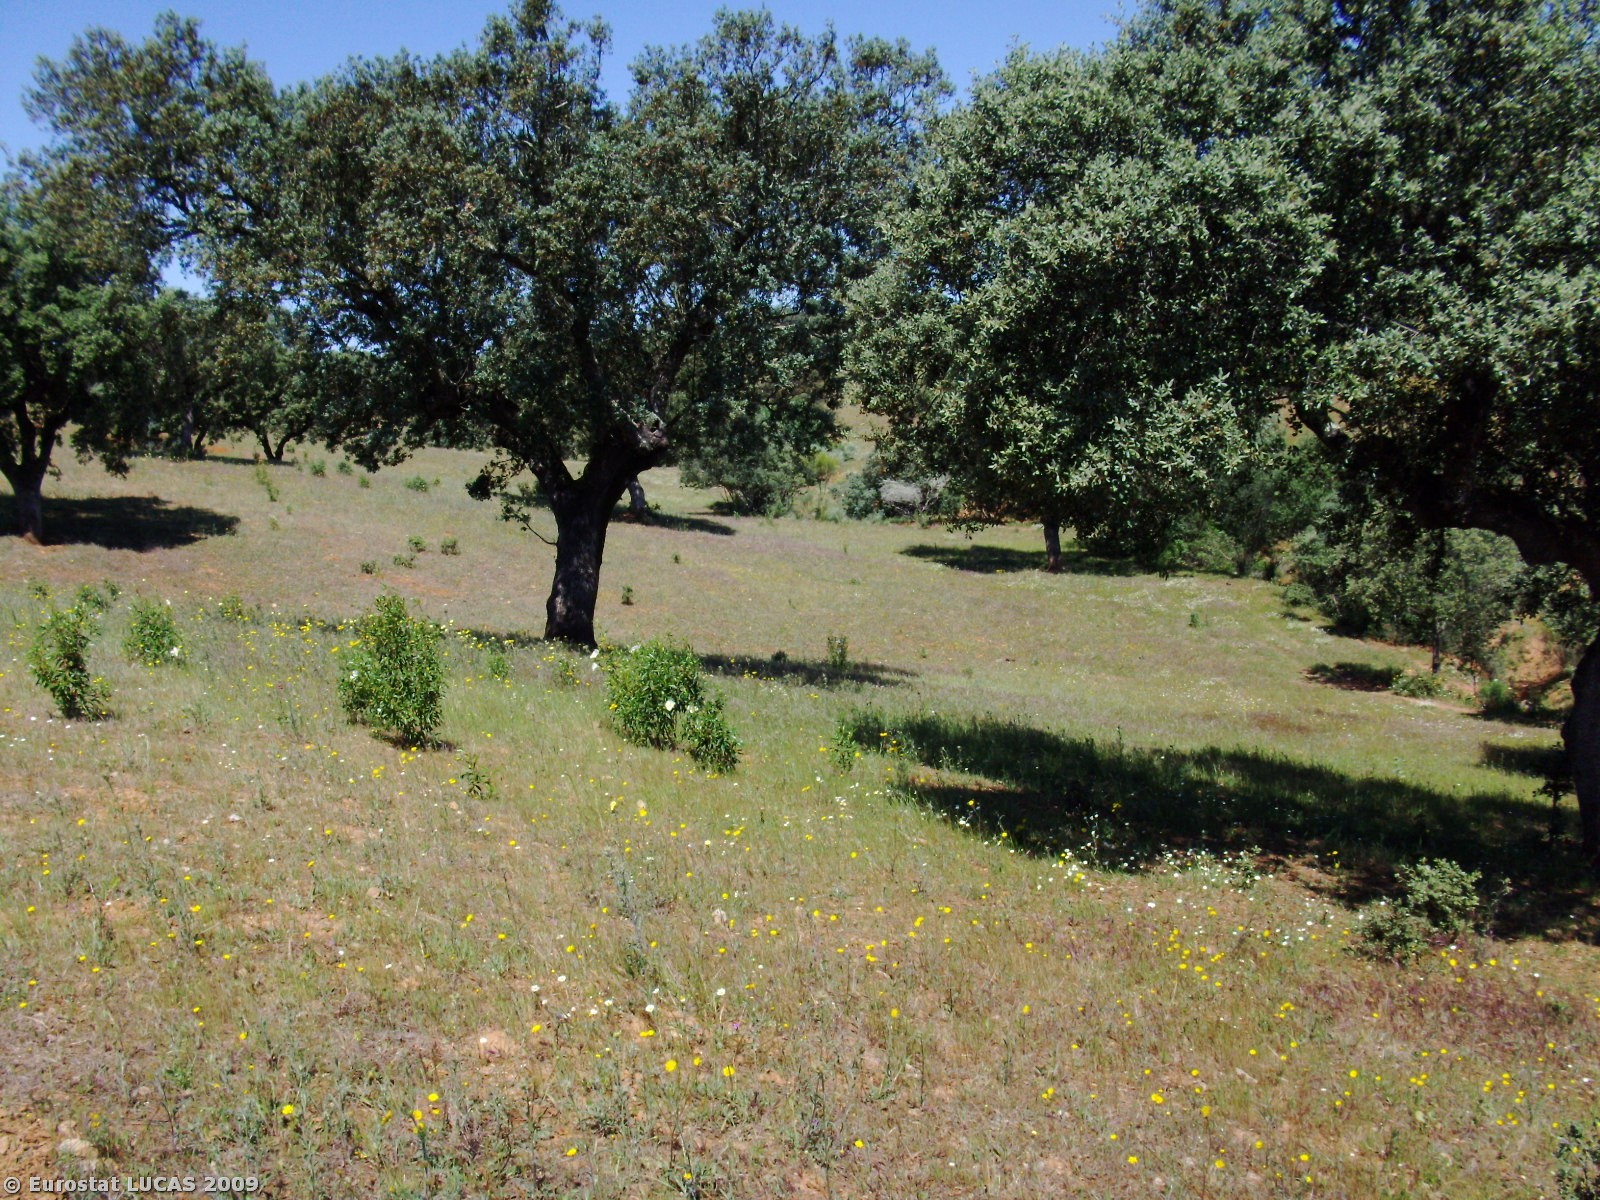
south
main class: Woodland
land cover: Broadleaved woodland
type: broadleaved evergreen forest
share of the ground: 10 - 25 %
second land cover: Spontaneously vegetated surfaces
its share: 10 - 25 %
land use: Agriculture (excluding fallow land and kitchen gardens)
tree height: > 5 m
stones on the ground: 25 - 50 %
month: May
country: PT
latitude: 38.5958
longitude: -7.6583
